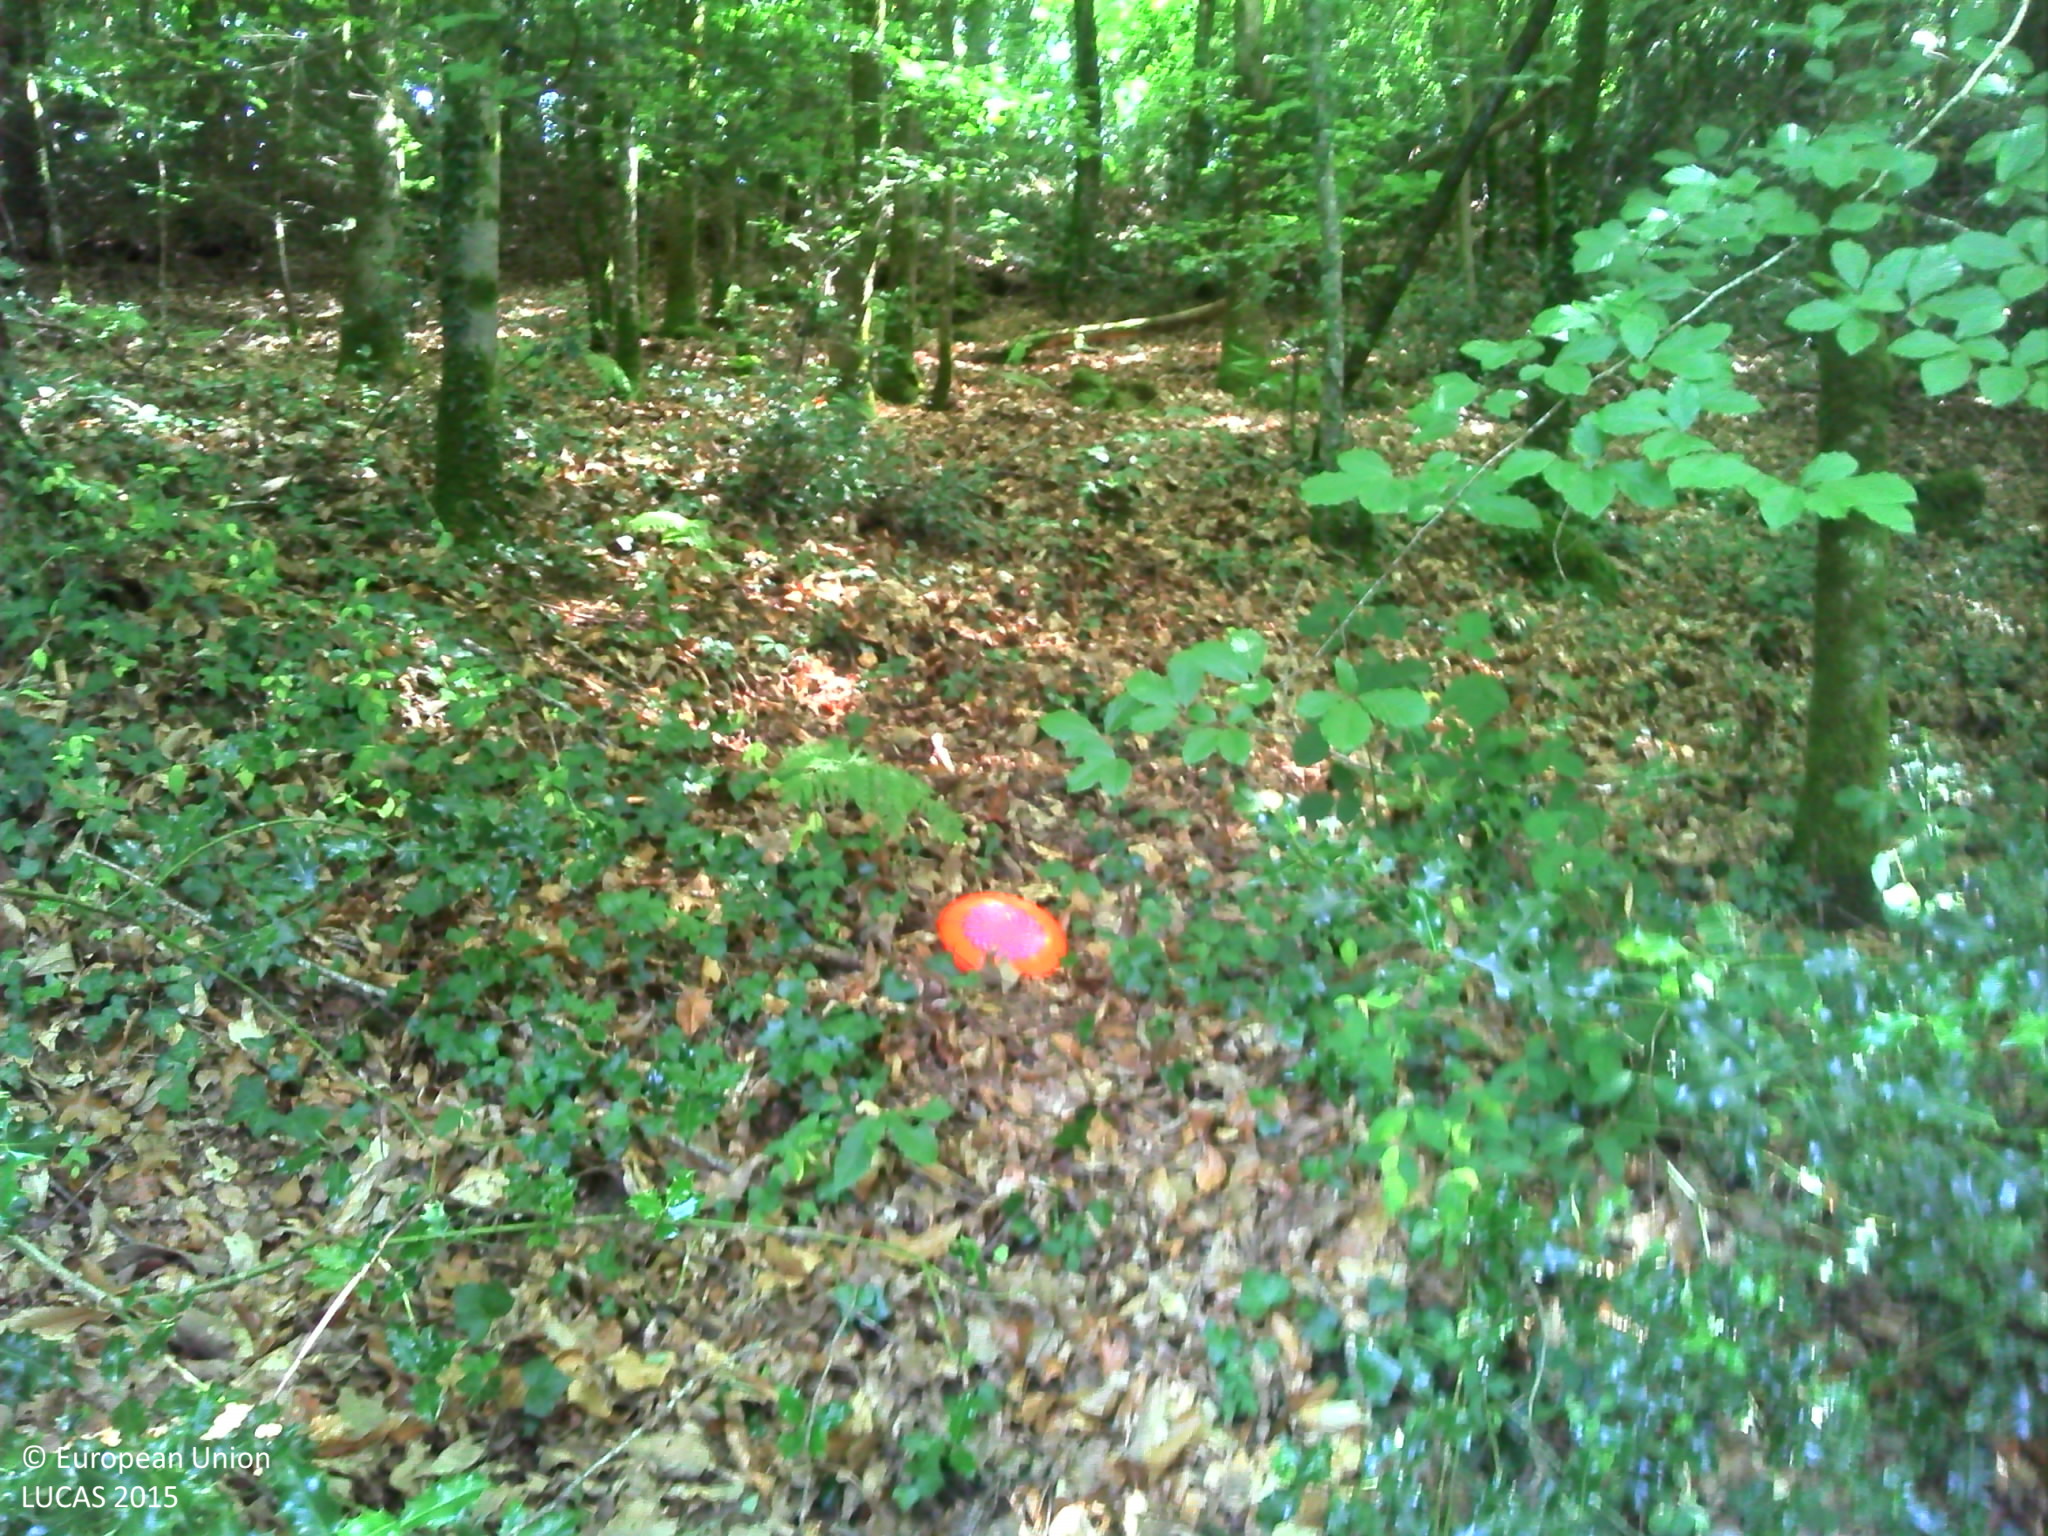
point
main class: Woodland
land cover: Broadleaved woodland
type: acidophilous oak and oak-birch forest
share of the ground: > 75 %
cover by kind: broadleaved forest trees 60 %, coniferous forest trees 10 %, shrubs 10 %, herbaceous plants 10 %, consolidated bare surface 10 %
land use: Forestry
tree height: > 5 m
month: July
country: FR
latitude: 47.9068
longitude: -3.1405
